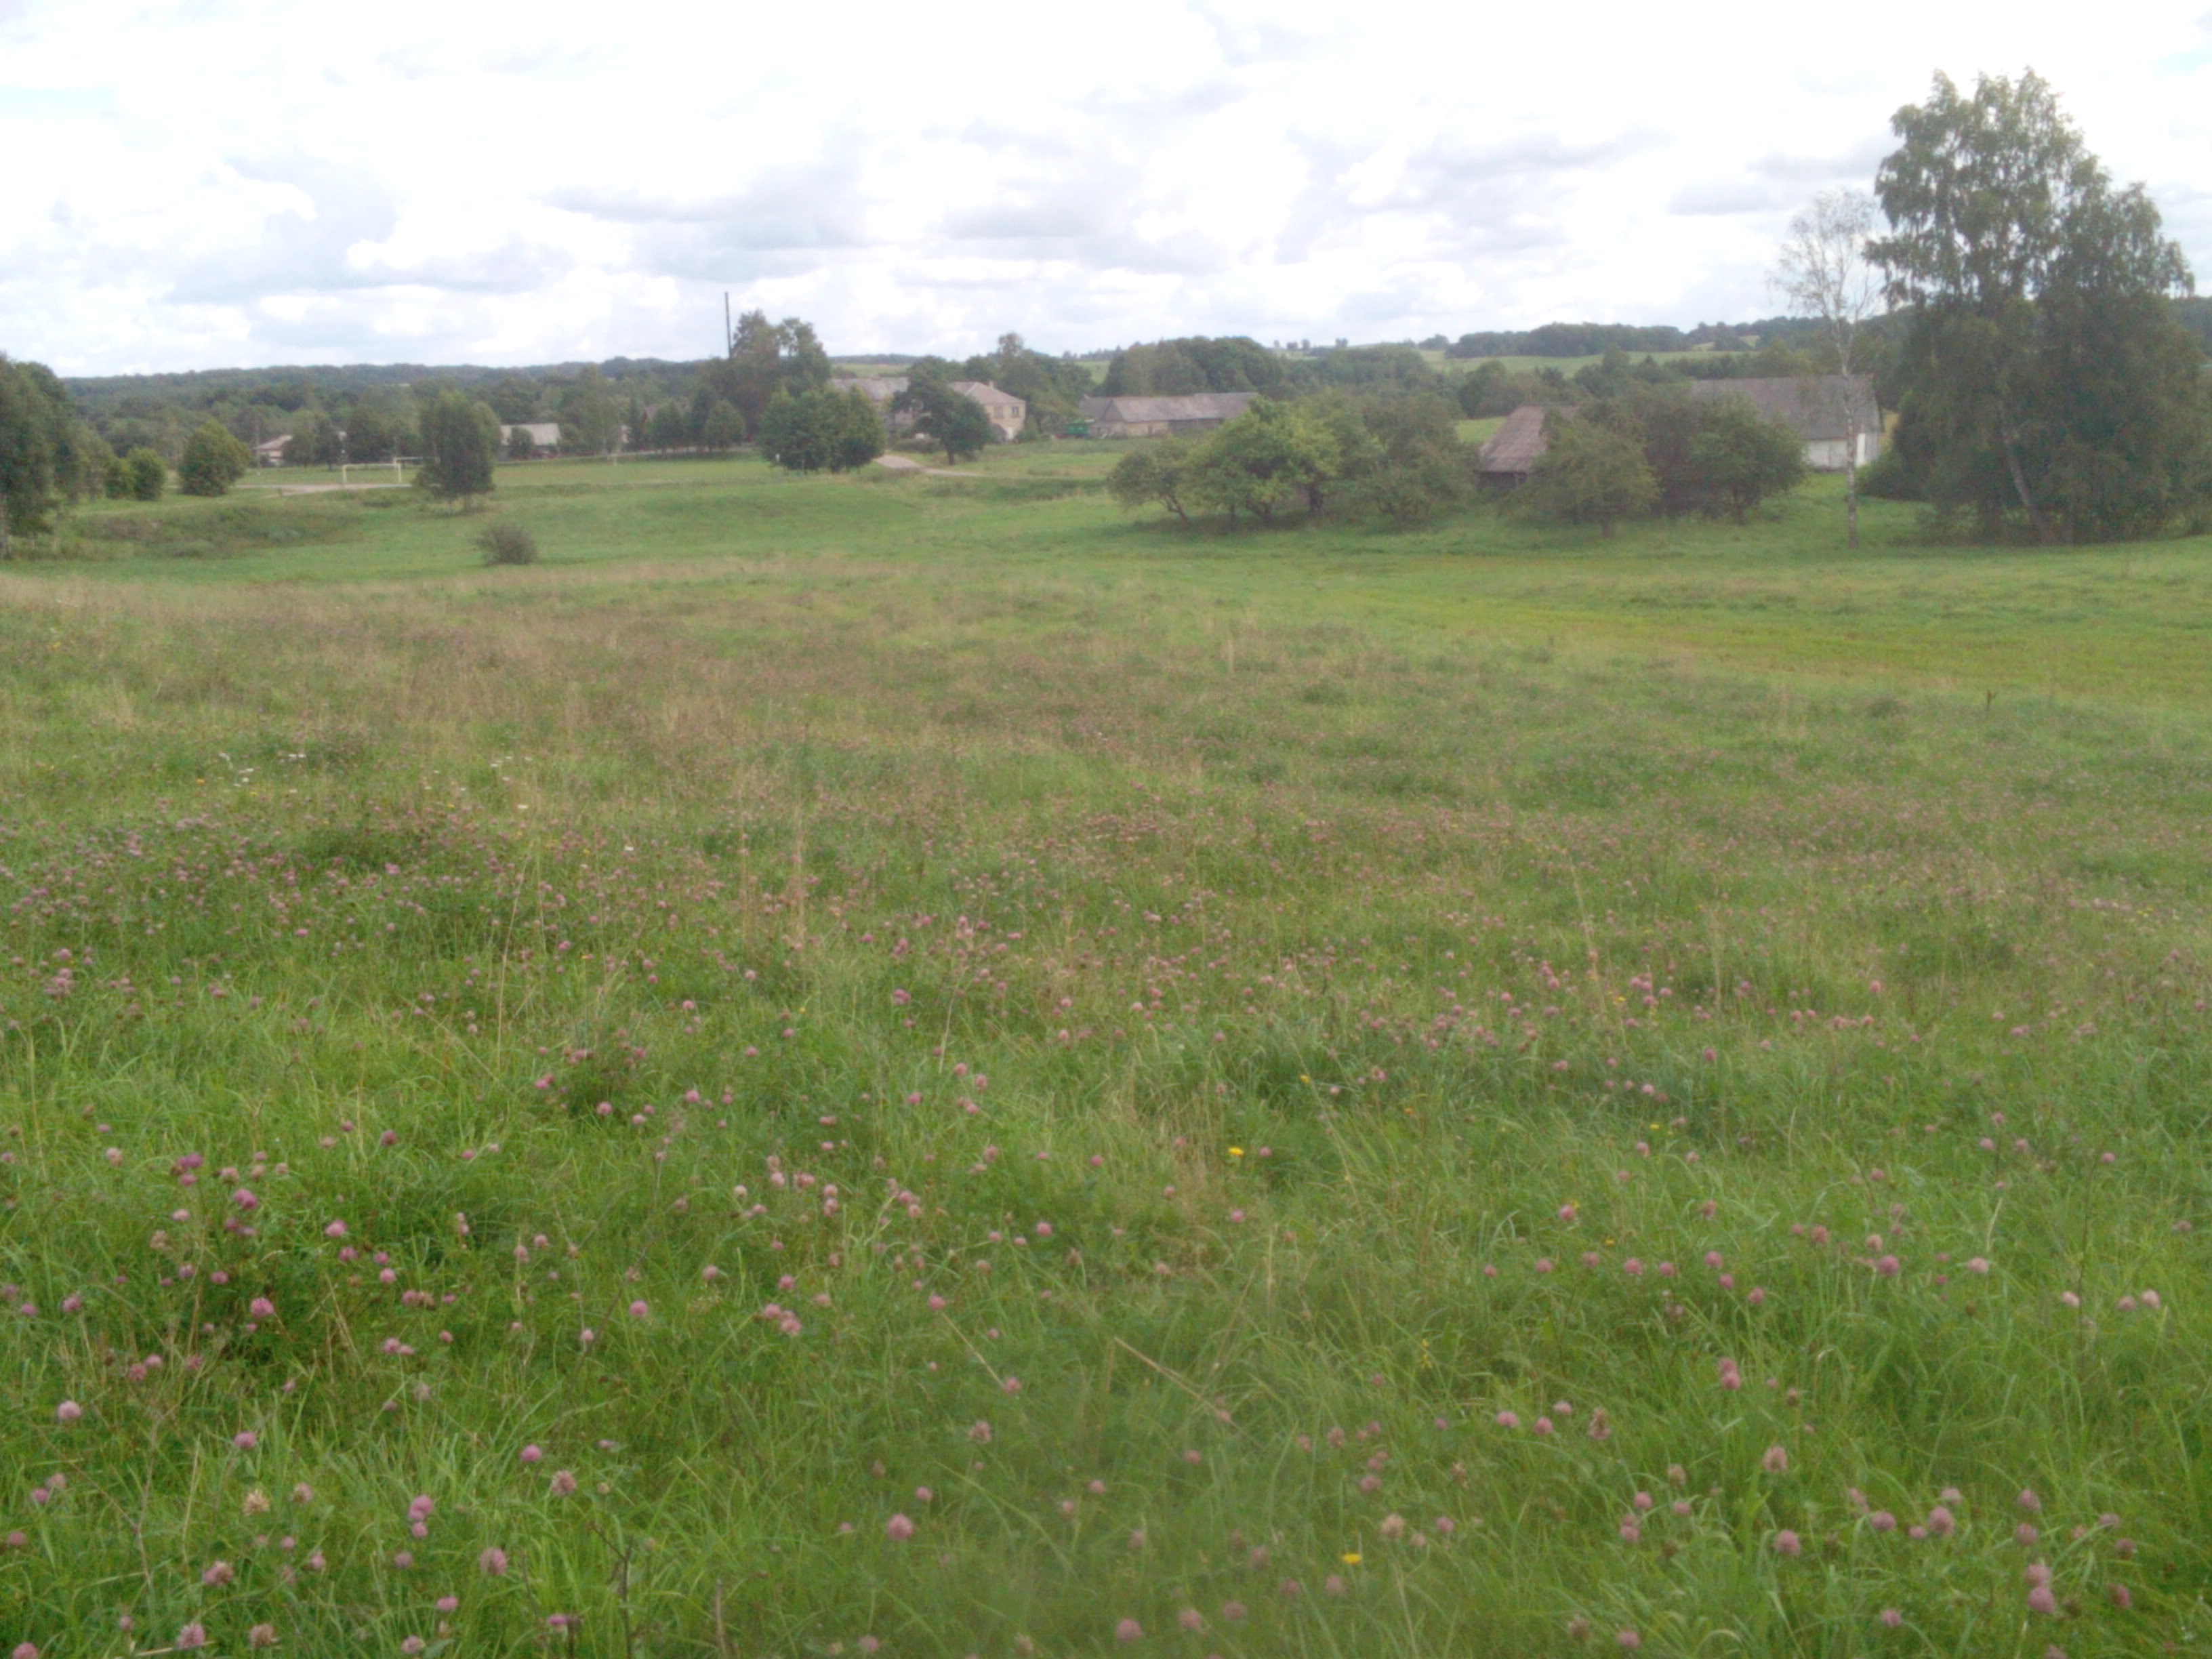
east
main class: Grassland
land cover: Grassland without tree/shrub cover
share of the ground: > 75 %
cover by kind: herbaceous plants 100 %
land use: Agriculture (excluding fallow land and kitchen gardens)
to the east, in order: Grassland without tree/shrub cover; Apple fruit; Artificial constructions in urban areas; Grassland without tree/shrub cover; Fences; Grass margins; Paved roads, cycling and walking lanes; Abandoned hedges; Common wheat
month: September
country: LT
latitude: 55.8559
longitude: 22.4071
